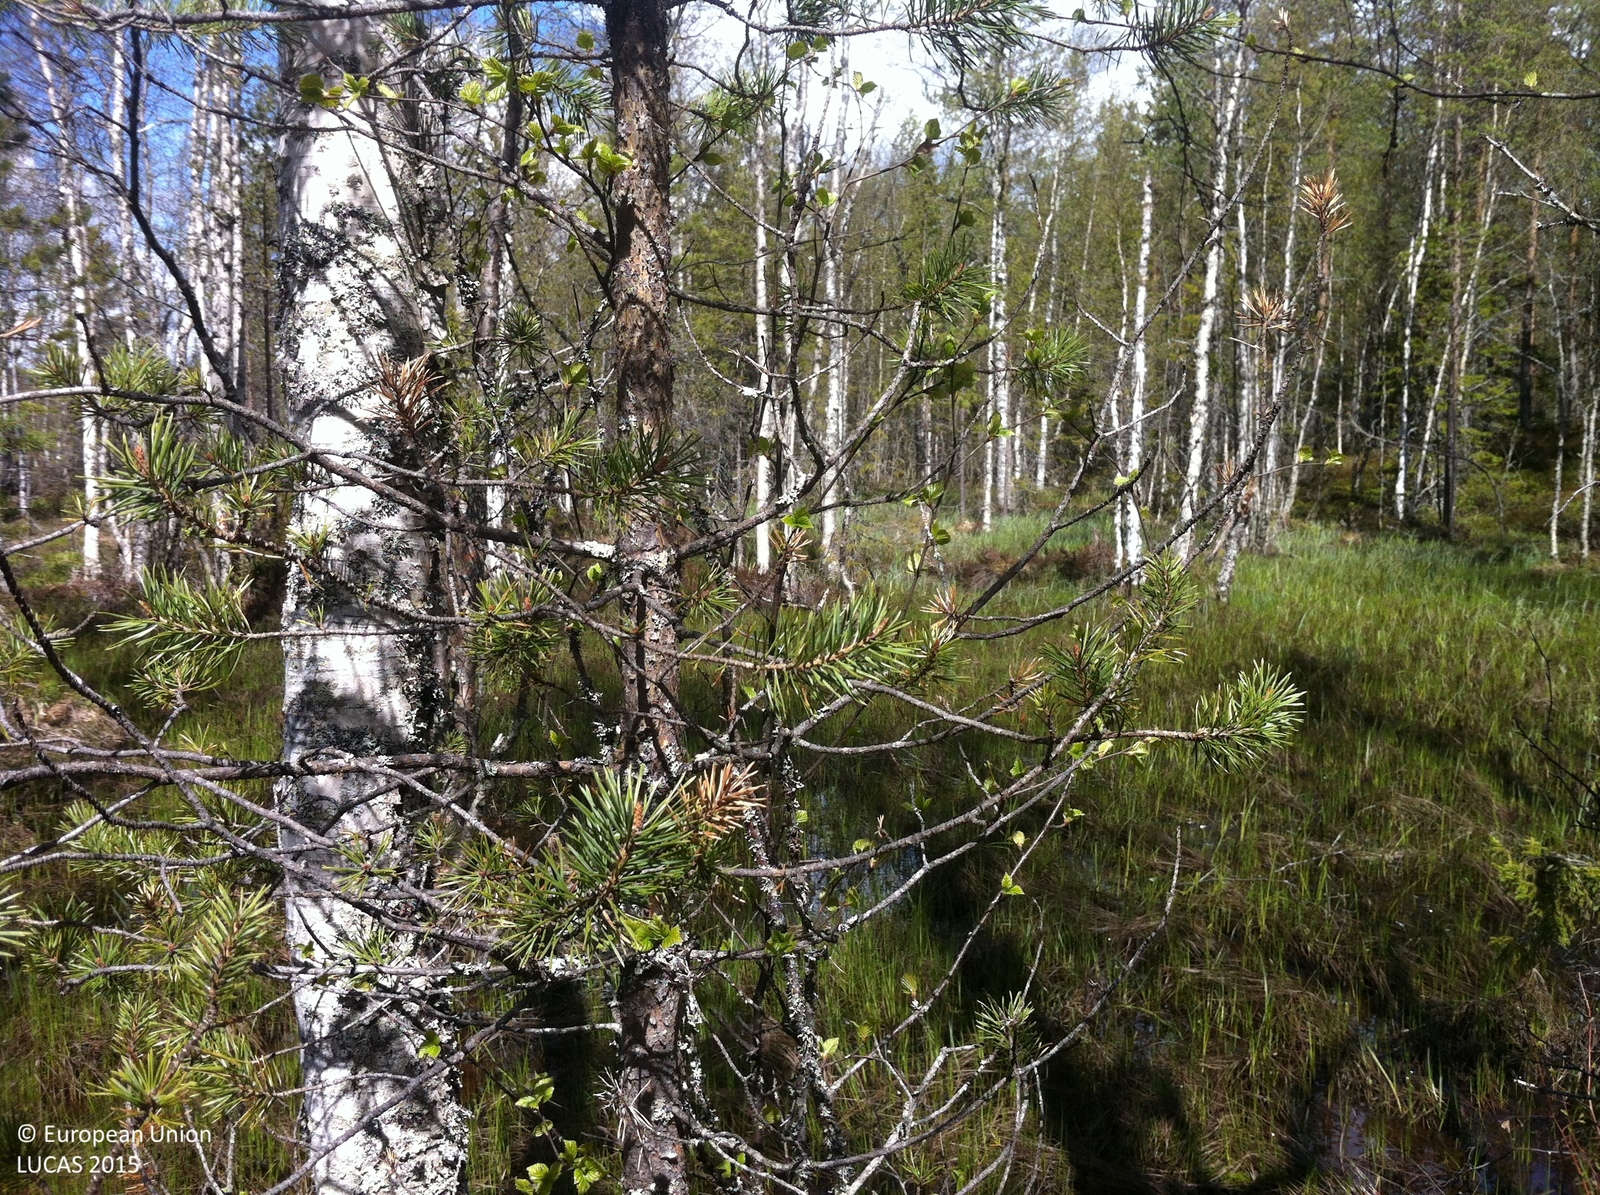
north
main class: Woodland
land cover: Pine dominated mixed woodland
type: boreal forest
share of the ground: 25 - 50 %
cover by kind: coniferous forest trees 30 %, shrubs 25 %, broadleaved forest trees 20 %, herbaceous plants 15 %, lichens and mosses 10 %
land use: Semi-natural and natural areas not in use
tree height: > 5 m
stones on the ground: < 10 %
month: June
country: SE
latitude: 61.0019
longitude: 13.5204
